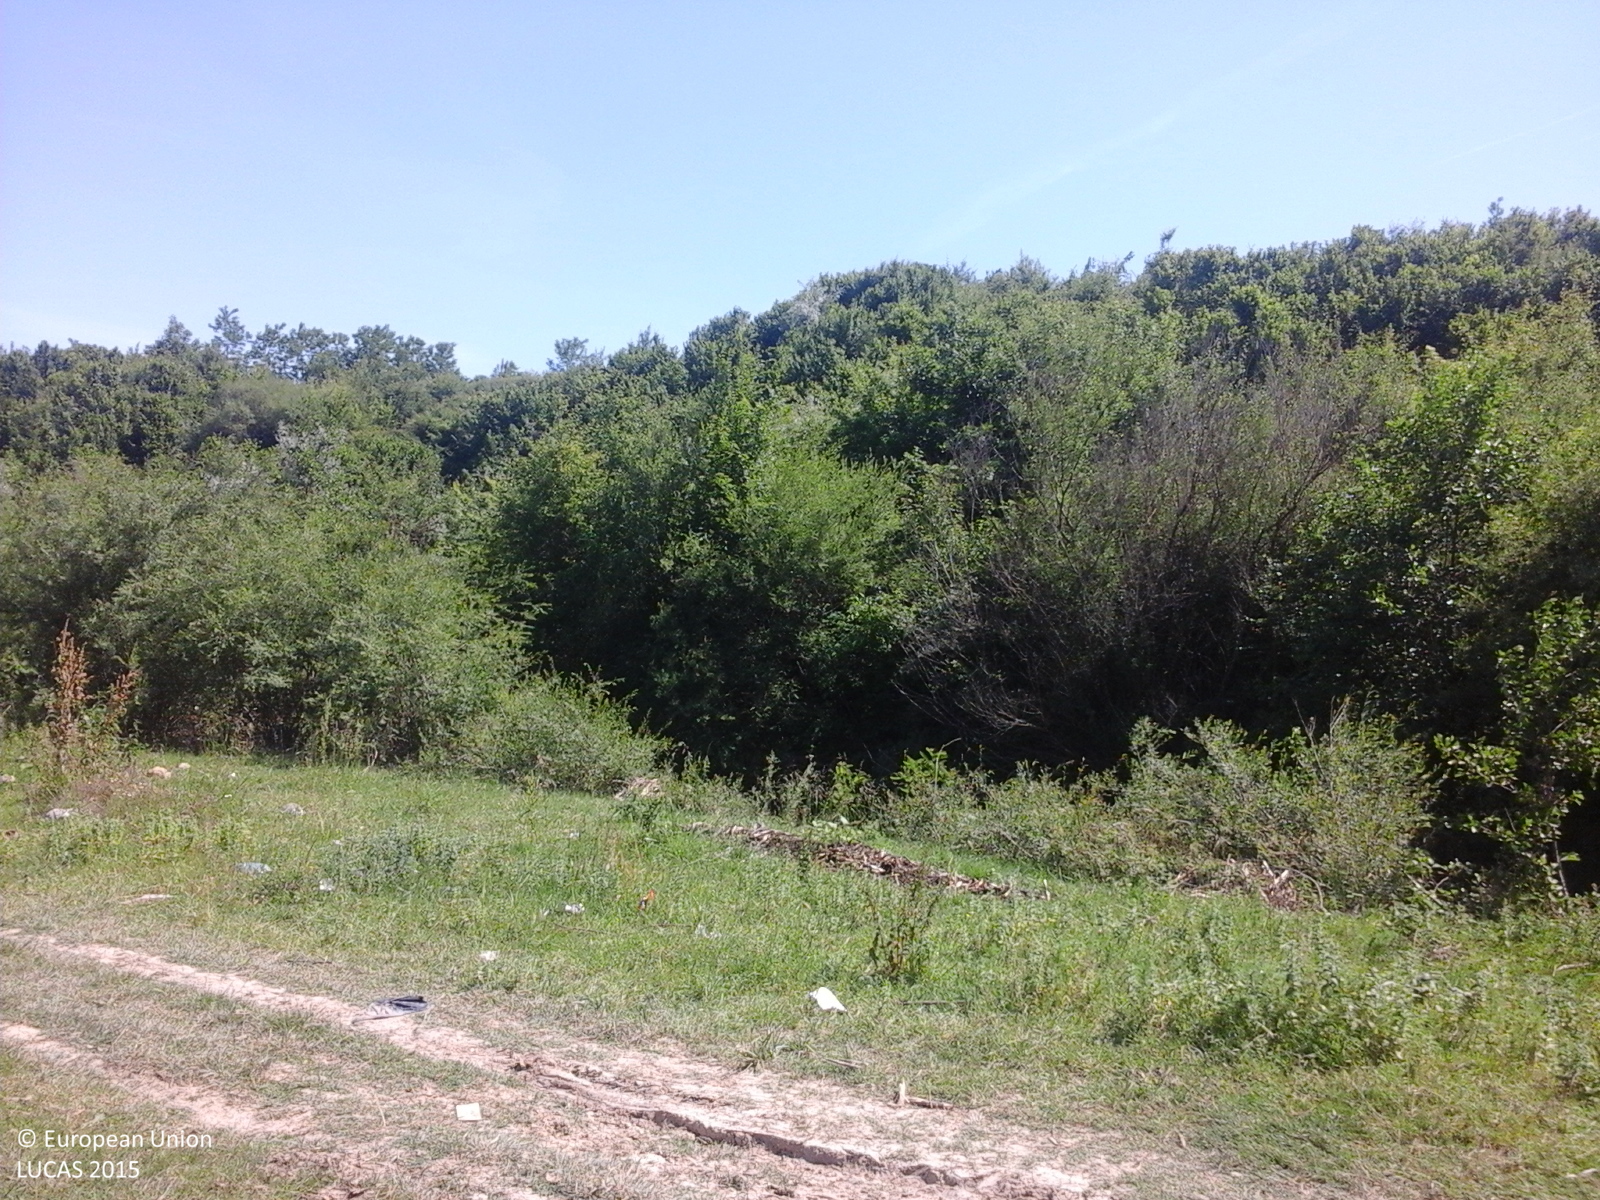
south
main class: Grassland
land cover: Grassland with sparse tree/shrub cover
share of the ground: > 75 %
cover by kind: herbaceous plants 85 %, shrubs 10 %, broadleaved forest trees 5 %
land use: Agriculture (excluding fallow land and kitchen gardens)
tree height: < 5 m
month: June
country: RO
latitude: 45.1149
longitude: 26.1417
